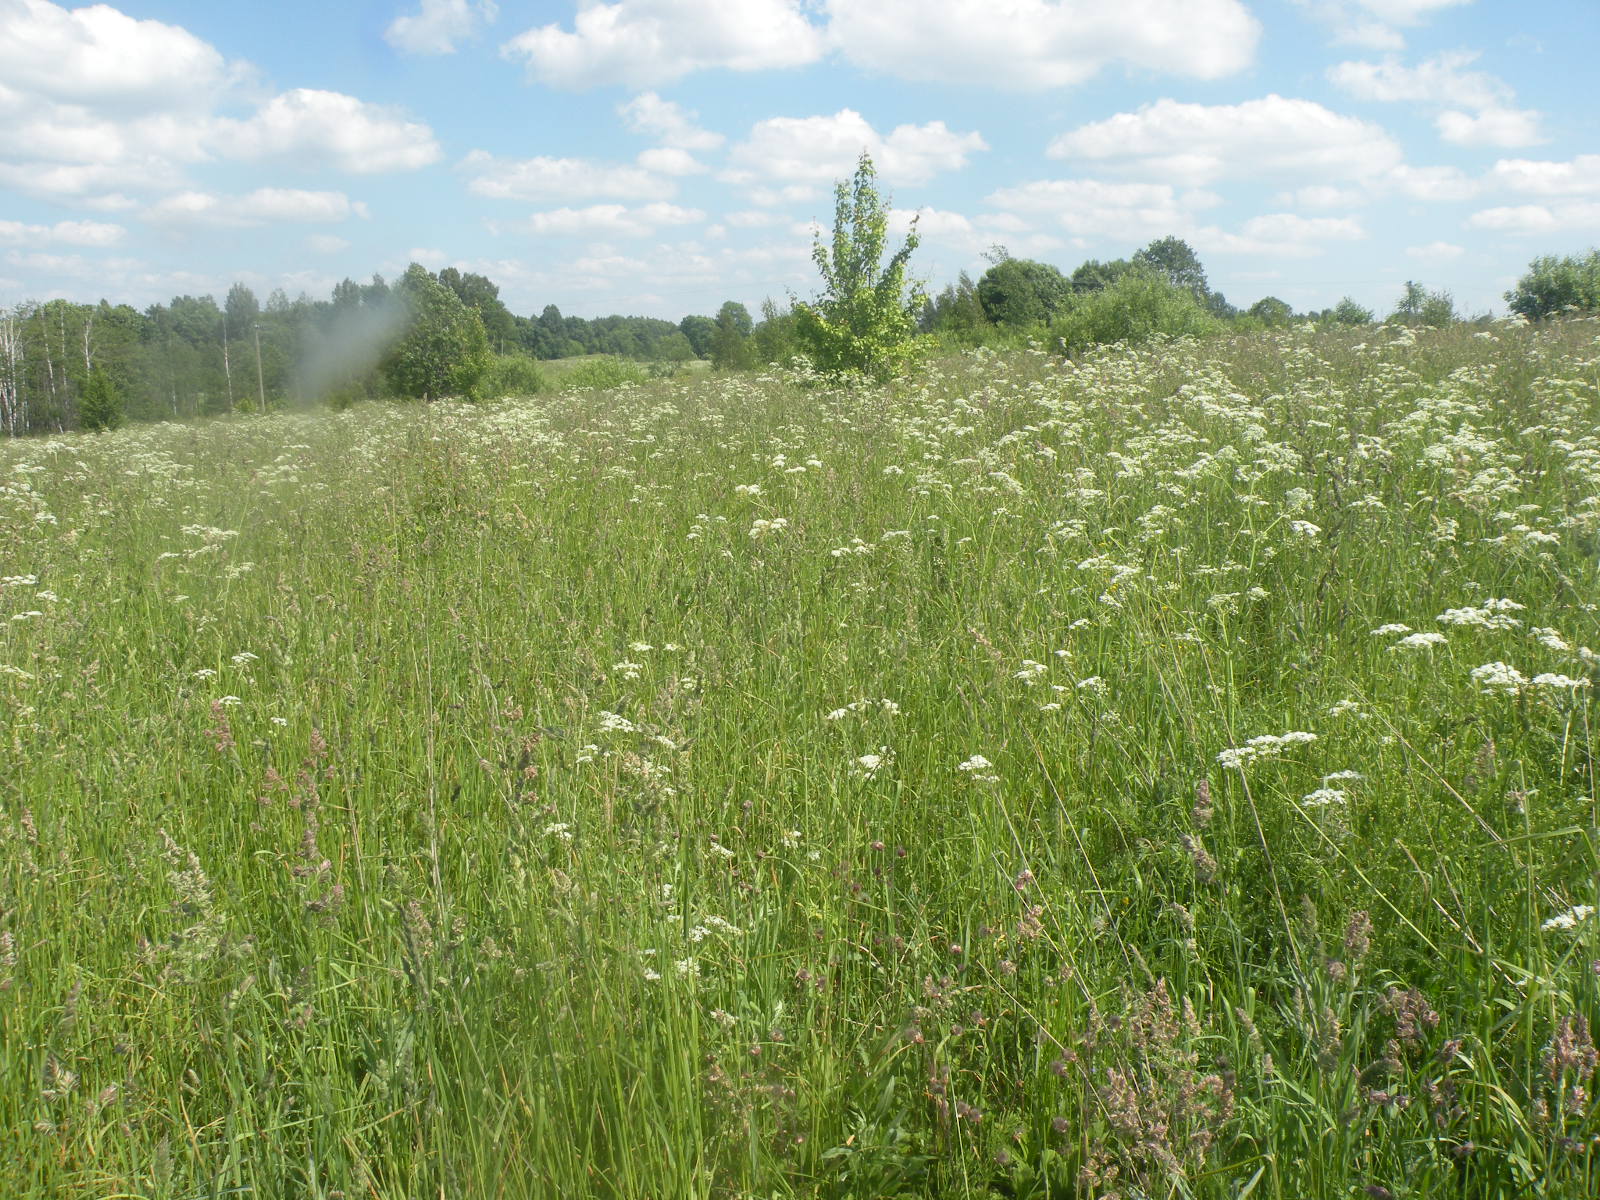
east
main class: Grassland
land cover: Spontaneously vegetated surfaces
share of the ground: > 75 %
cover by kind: herbaceous plants 100 %
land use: Semi-natural and natural areas not in use
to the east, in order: Spontaneously vegetated surfaces; Tracks; Single bushes/trees; Spontaneously vegetated surfaces
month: June
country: LV
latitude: 56.1302
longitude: 26.8442
